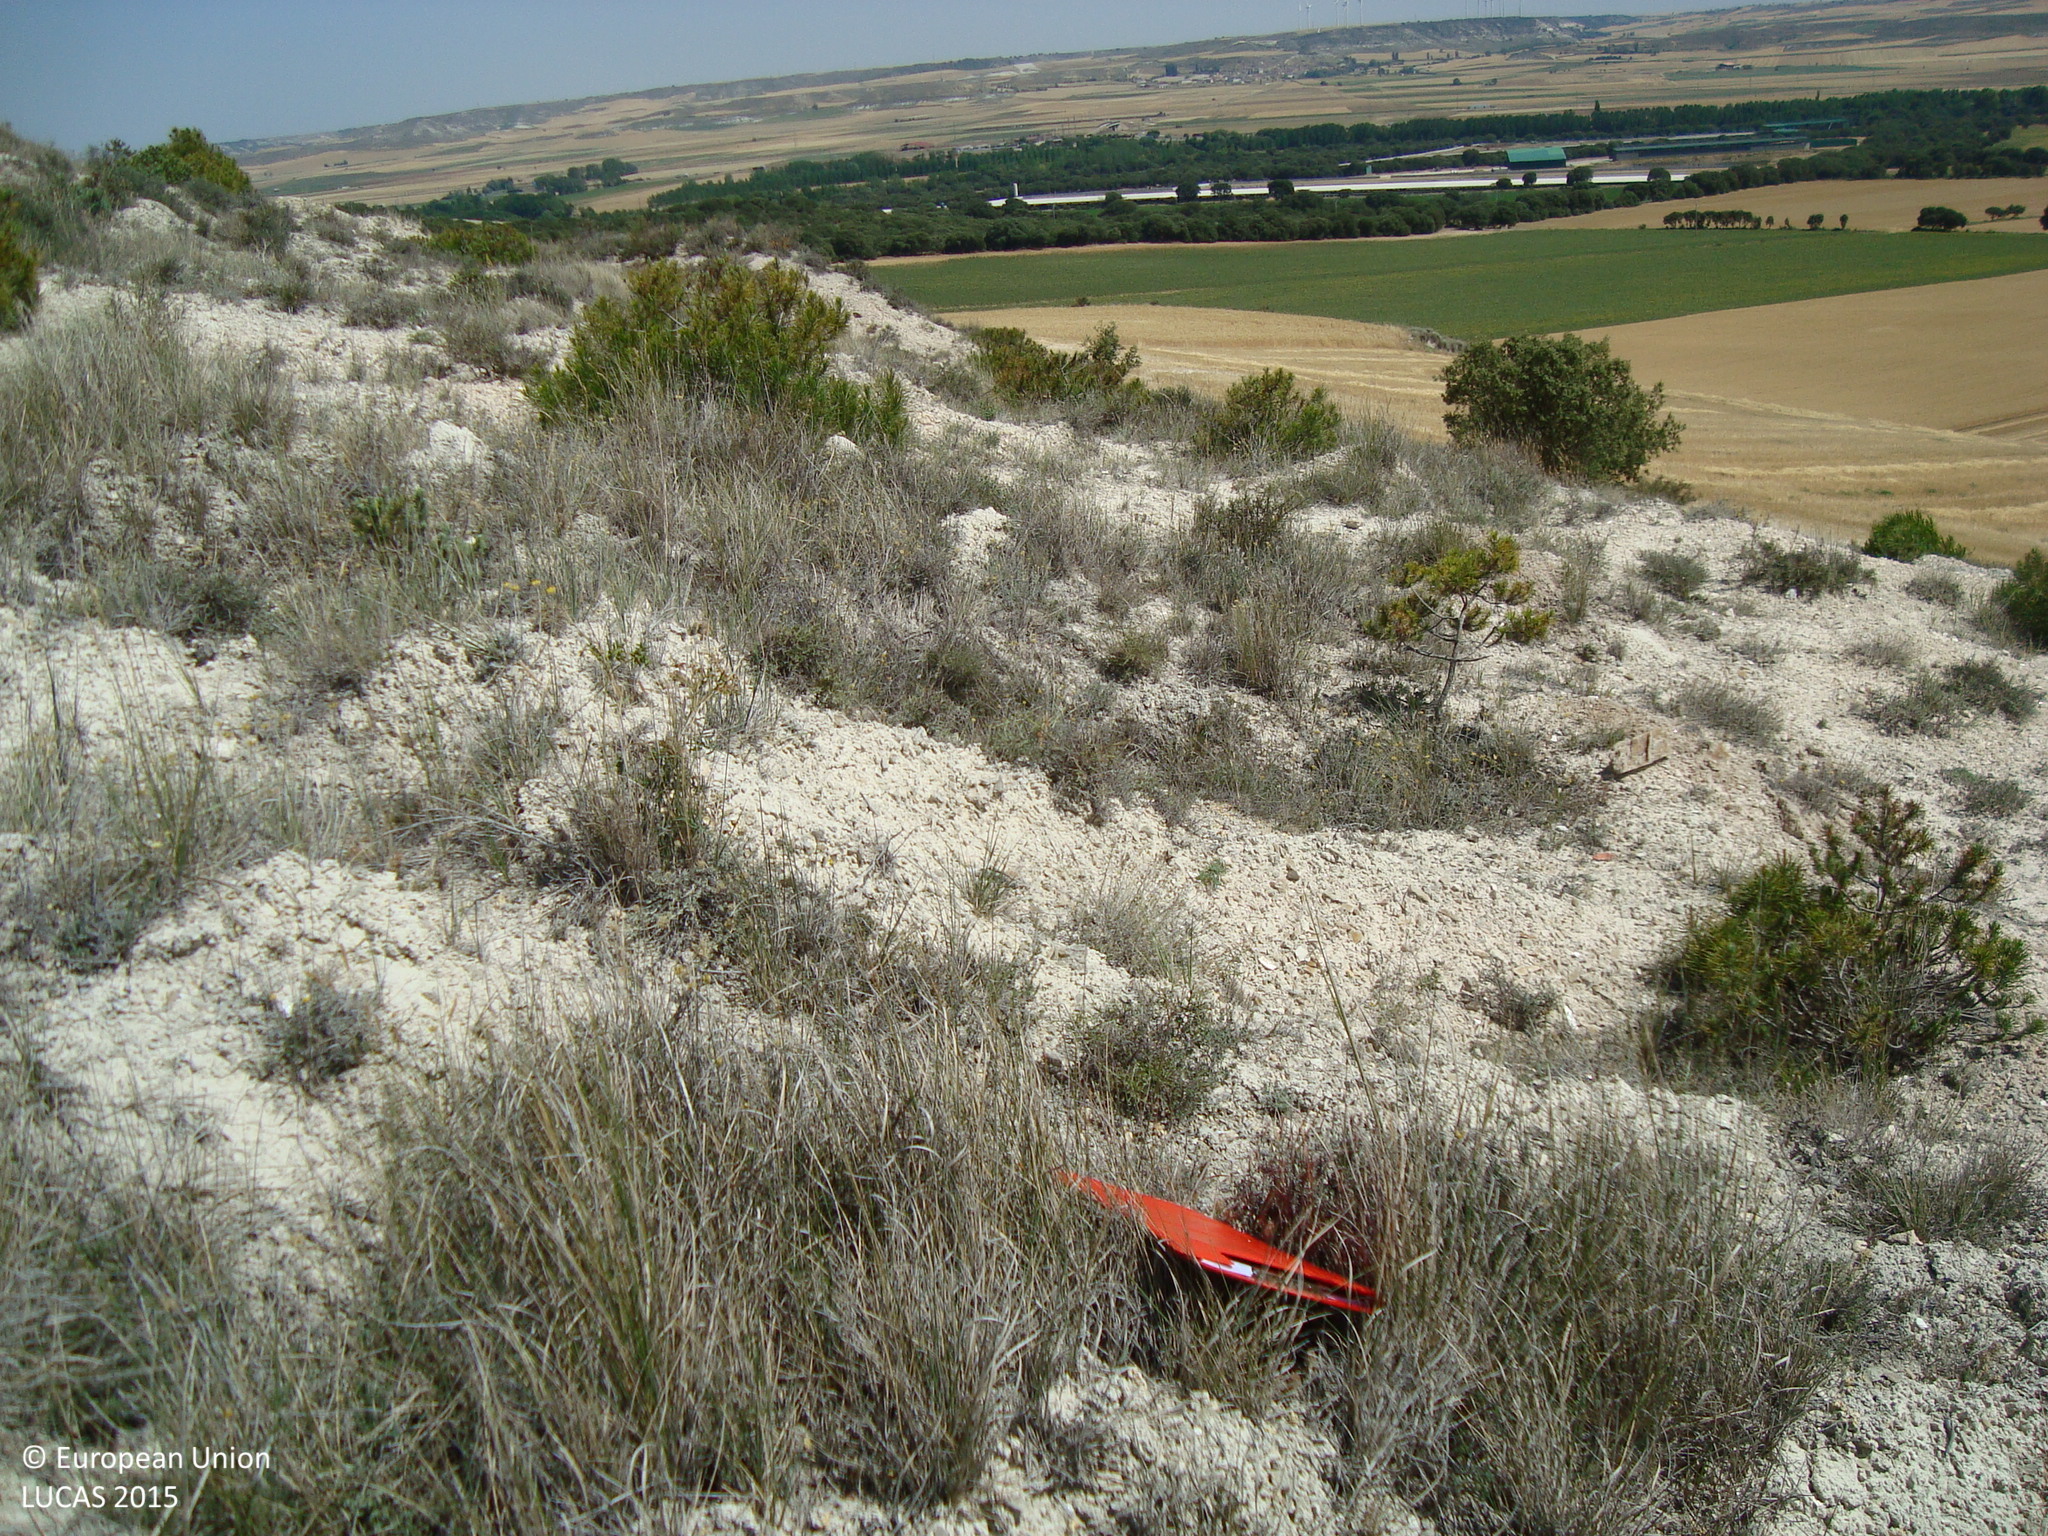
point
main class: Woodland
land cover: Pine dominated coniferous woodland
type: coniferous forest of the mediterranean region
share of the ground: 10 - 25 %
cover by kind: unconsolidated bare surface 75 %, coniferous forest trees 10 %, shrubs 10 %, herbaceous plants 5 %
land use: Forestry
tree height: < 5 m
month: July
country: ES
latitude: 42.0807
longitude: -4.2455
